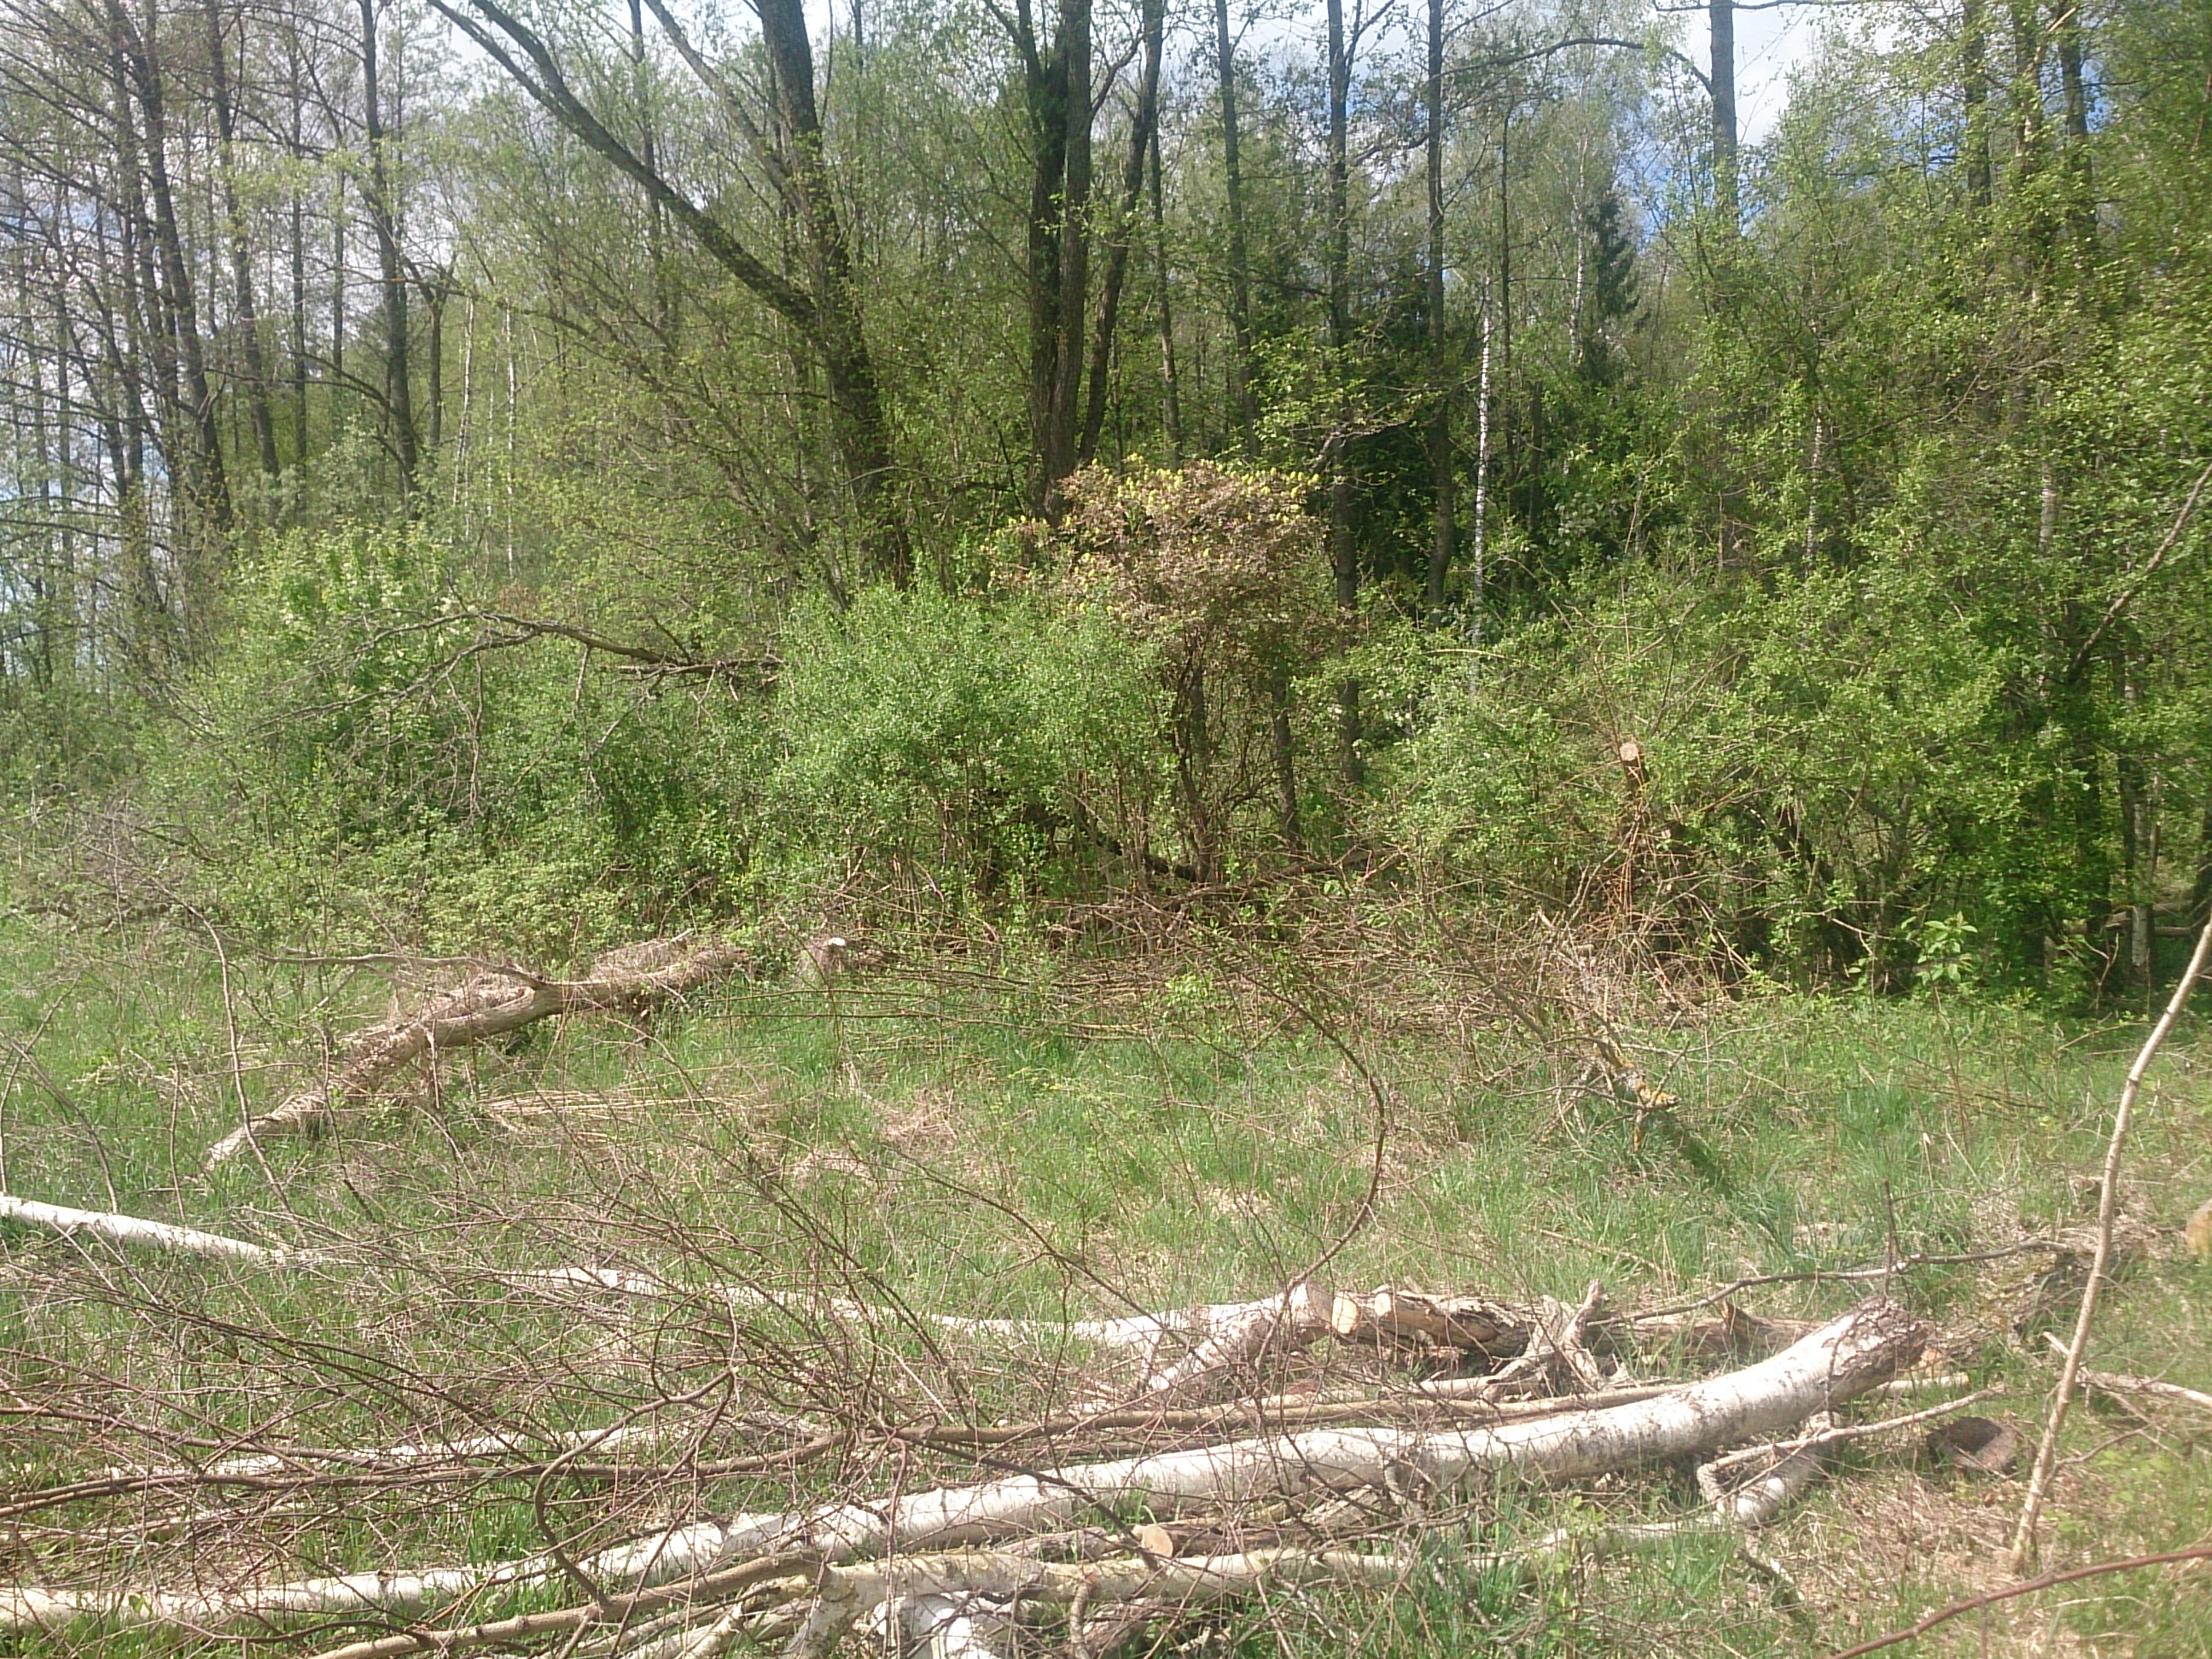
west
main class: Shrubland
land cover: Shrubland without tree cover
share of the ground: > 75 %
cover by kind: shrubs 90 %, herbaceous plants 10 %
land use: Abandoned areas
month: May
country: LV
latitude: 56.7603
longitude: 24.0712
